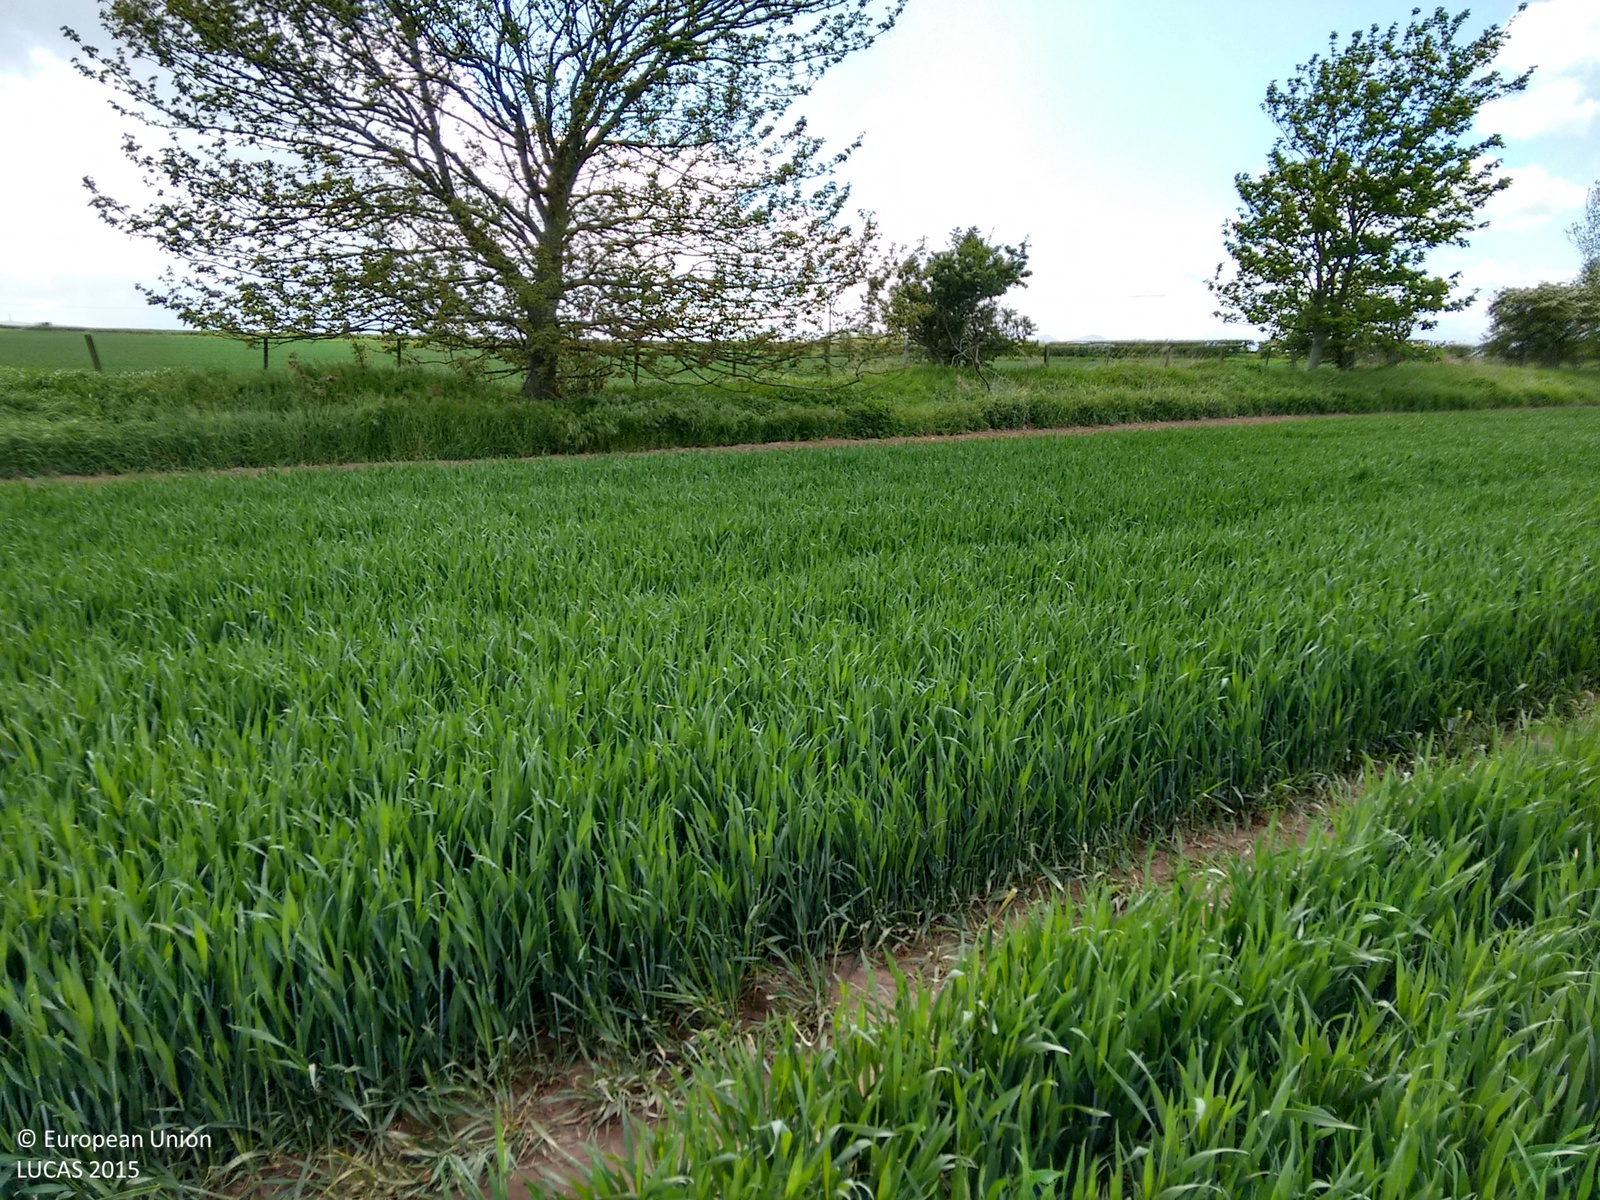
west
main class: Cropland
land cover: Barley
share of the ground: > 75 %
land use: Agriculture (excluding fallow land and kitchen gardens)
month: May
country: GB
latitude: 55.5786
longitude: -2.4484
